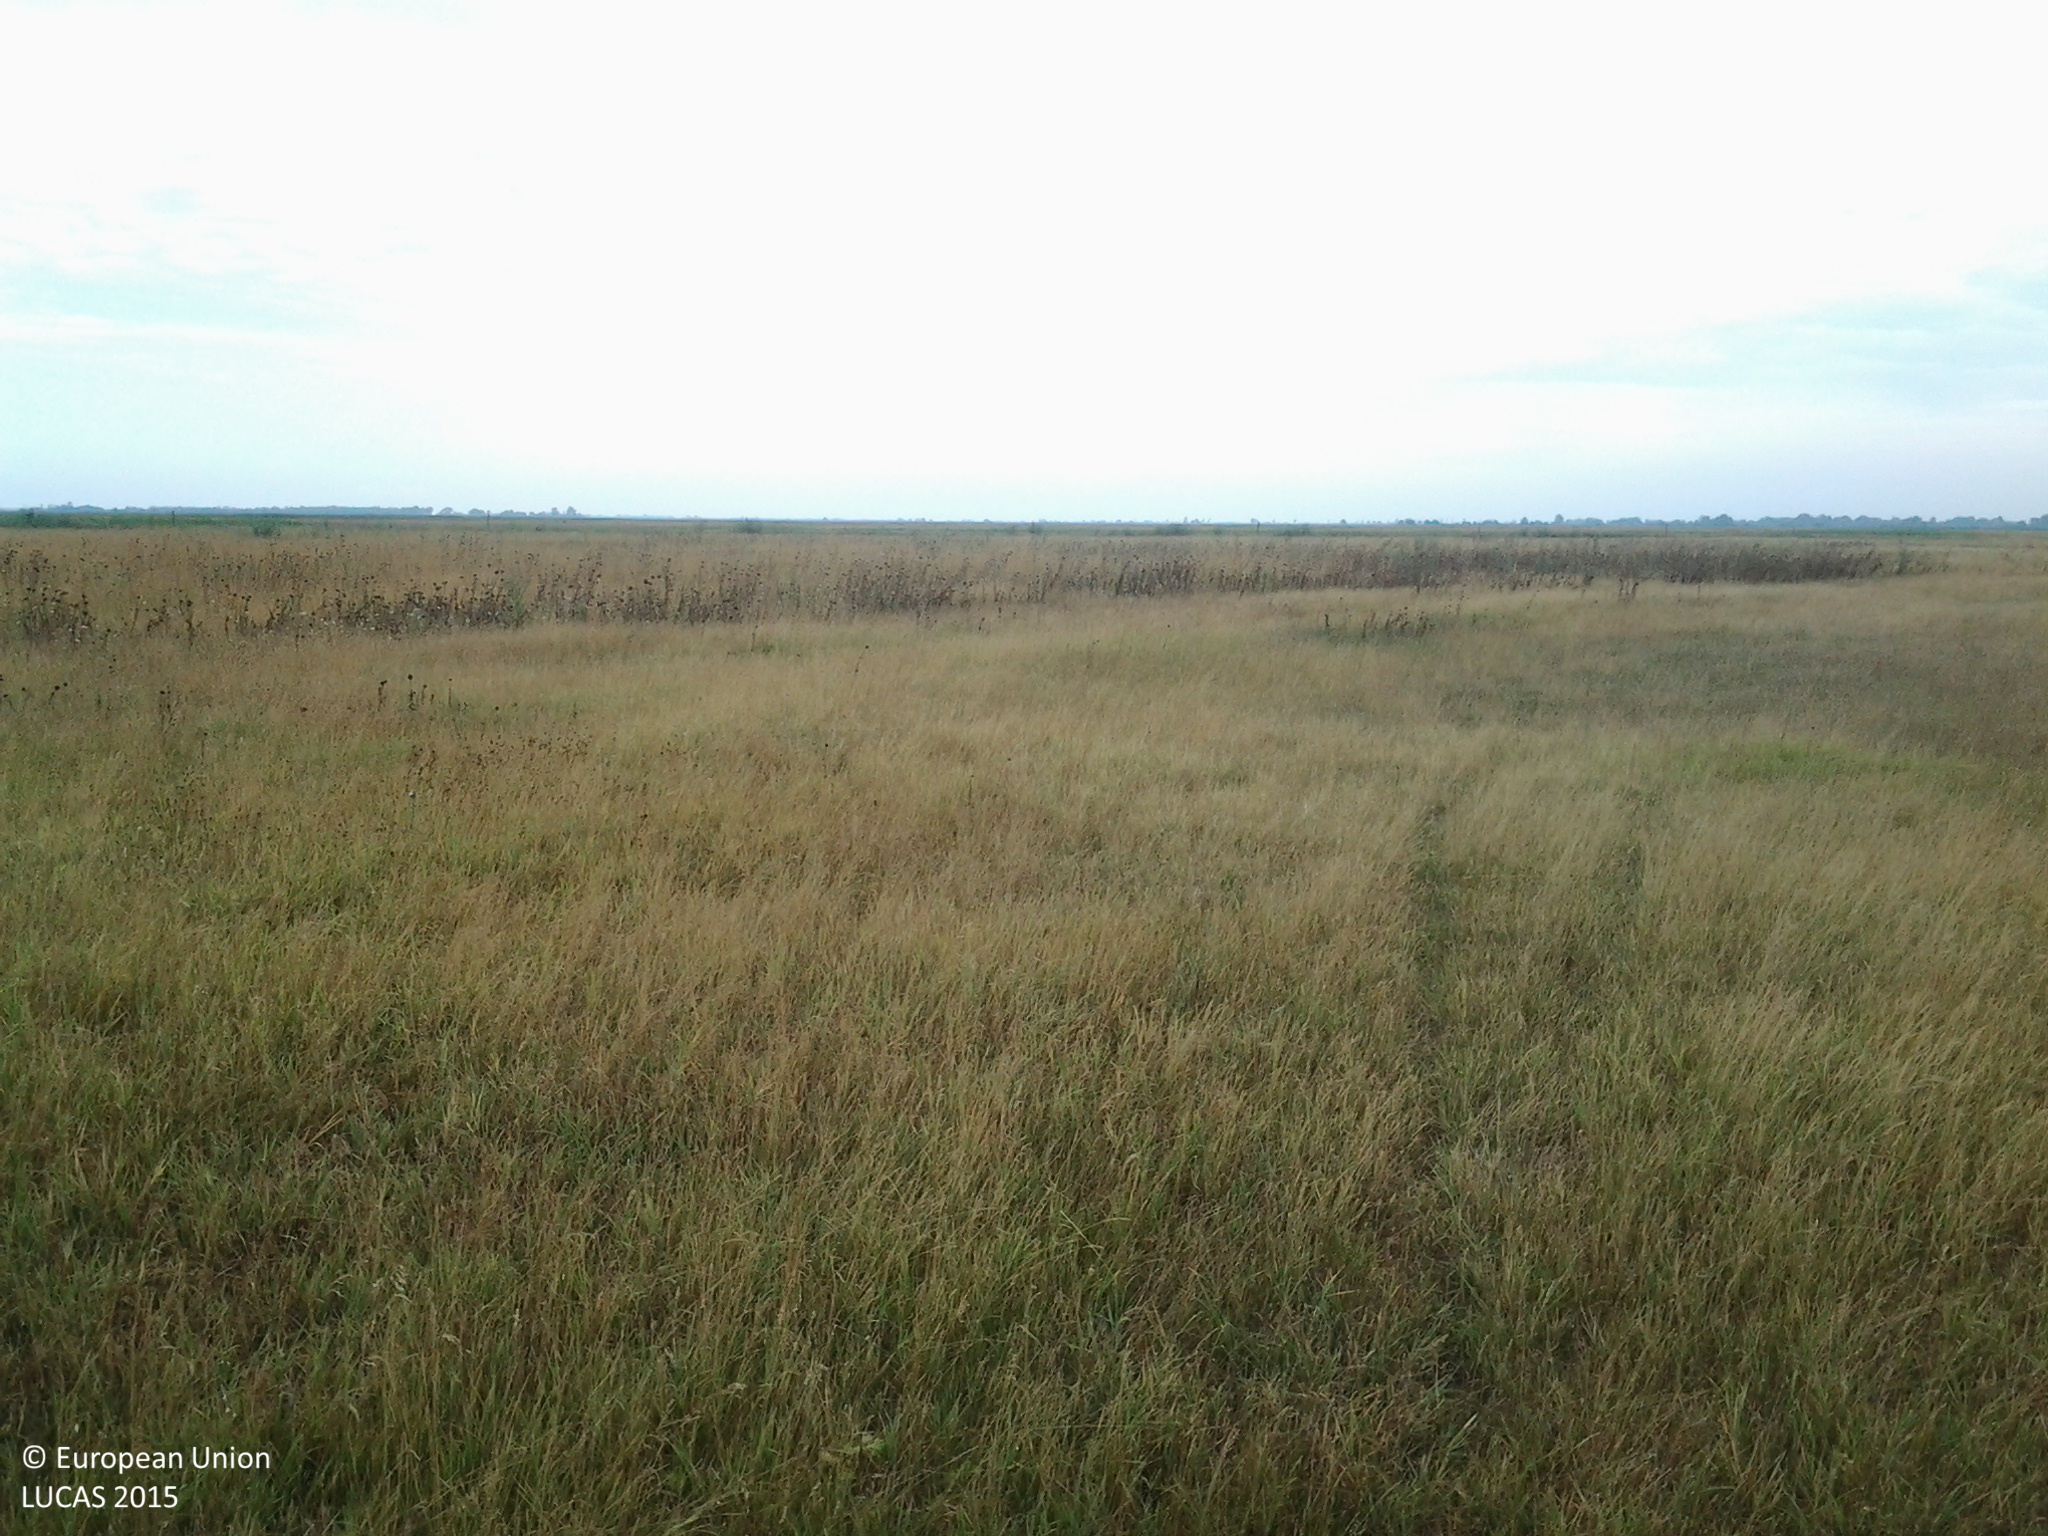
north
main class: Grassland
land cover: Grassland without tree/shrub cover
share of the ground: > 75 %
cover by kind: herbaceous plants 100 %
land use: Agriculture (excluding fallow land and kitchen gardens)
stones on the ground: < 10 %
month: July
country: HU
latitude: 47.0821
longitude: 19.1447
